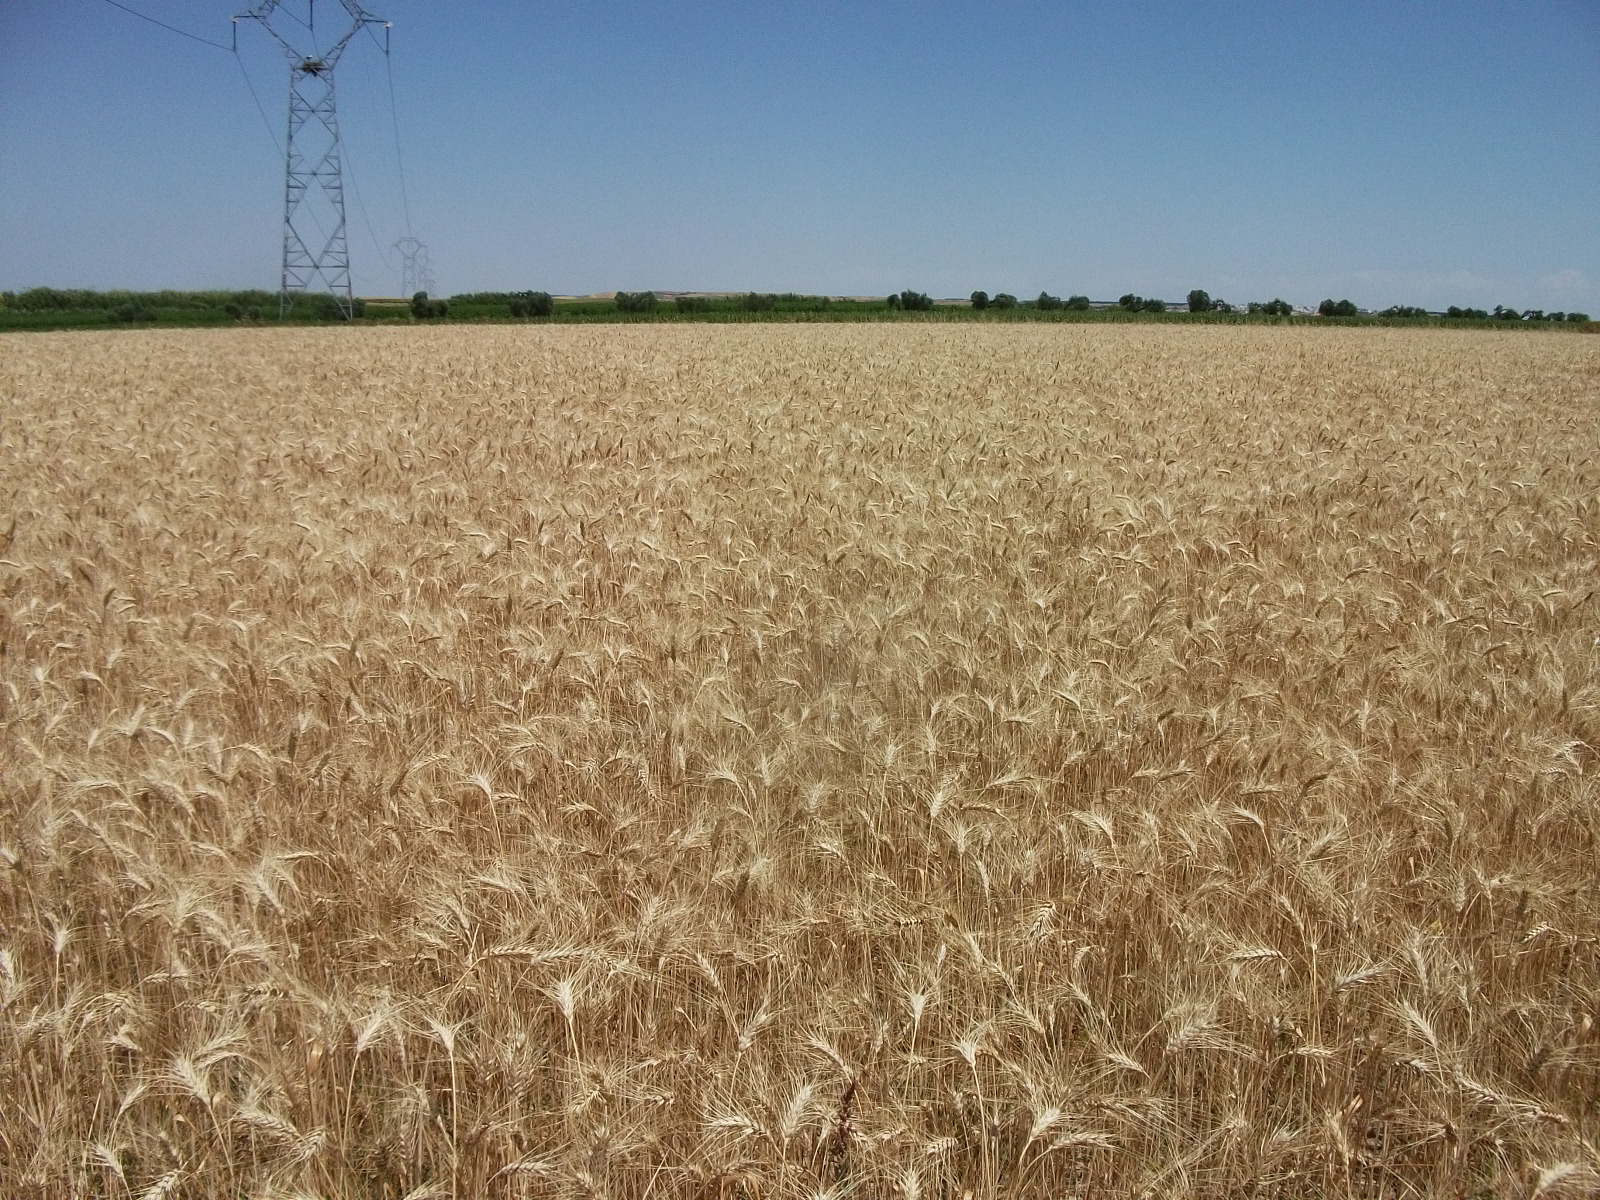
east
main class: Cropland
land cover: Durum wheat
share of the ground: > 75 %
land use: Agriculture (excluding fallow land and kitchen gardens)
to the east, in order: Durum wheat; Grass margins; Sunflower; Dry pulses; Grass margins; Olive groves; Grass margins; Tracks; Sunflower
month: June
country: ES
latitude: 37.4141
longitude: -6.5409
